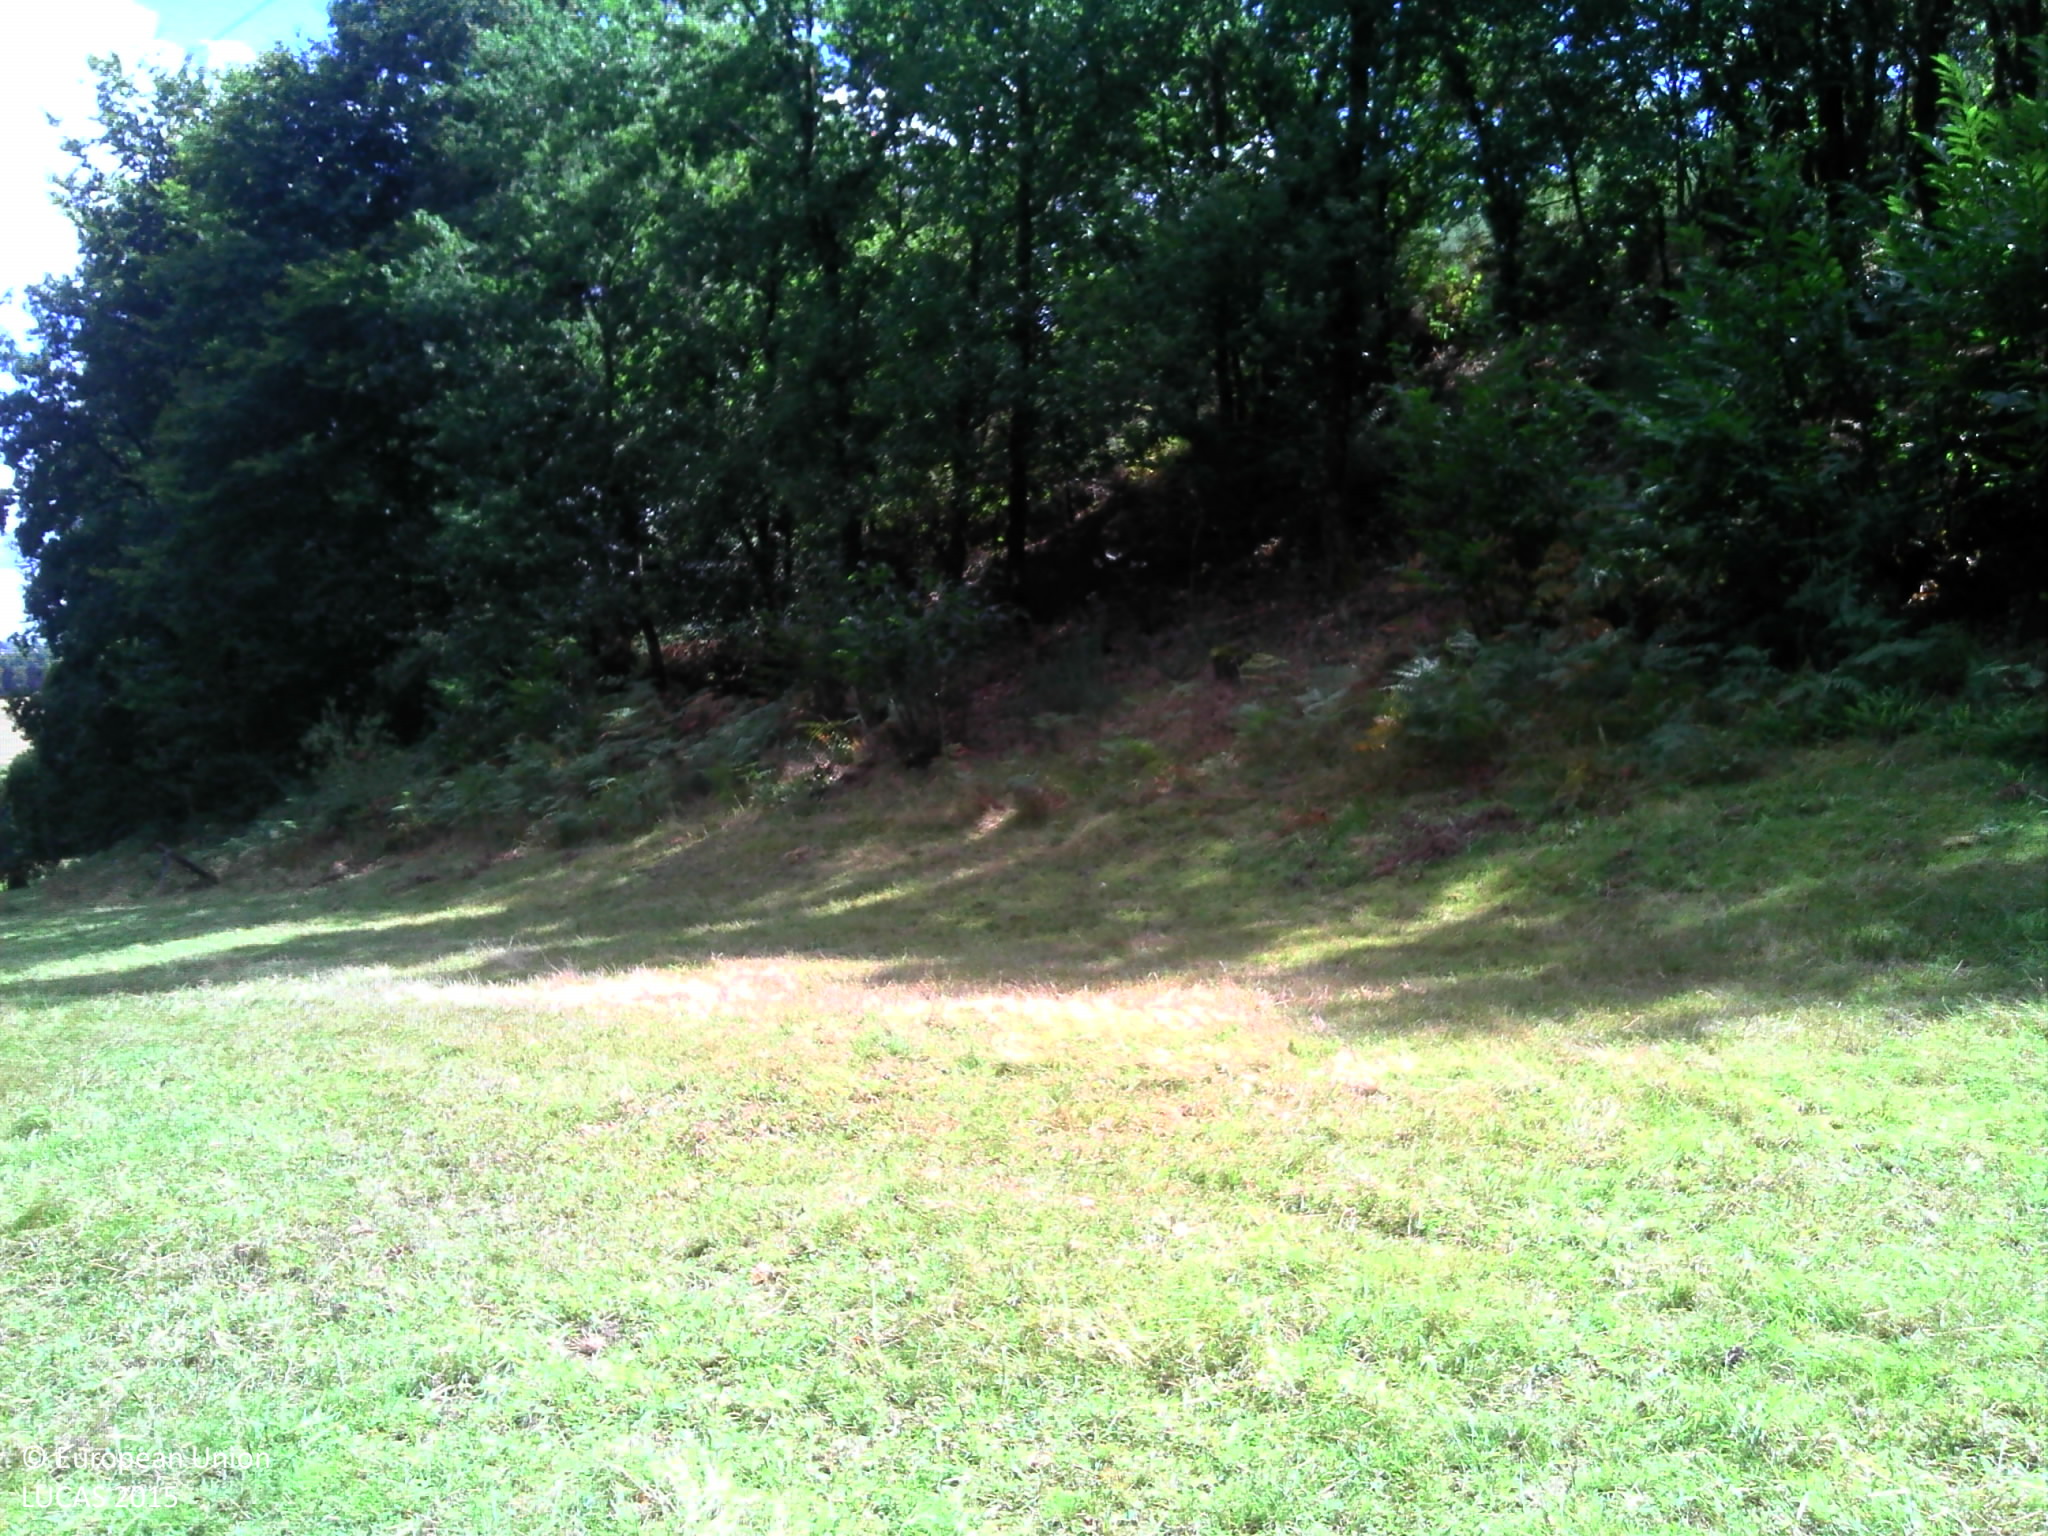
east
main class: Grassland
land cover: Grassland without tree/shrub cover
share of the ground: > 75 %
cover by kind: herbaceous plants 100 %
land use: Agriculture (excluding fallow land and kitchen gardens)
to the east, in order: Grassland without tree/shrub cover; Broadleaved woodland; Electric lines; Broadleaved woodland; Spontaneously vegetated surfaces; Broadleaved woodland; Maize; Ditches and canals; Grass margins
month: August
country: FR
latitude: 47.7840
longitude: -2.3218
